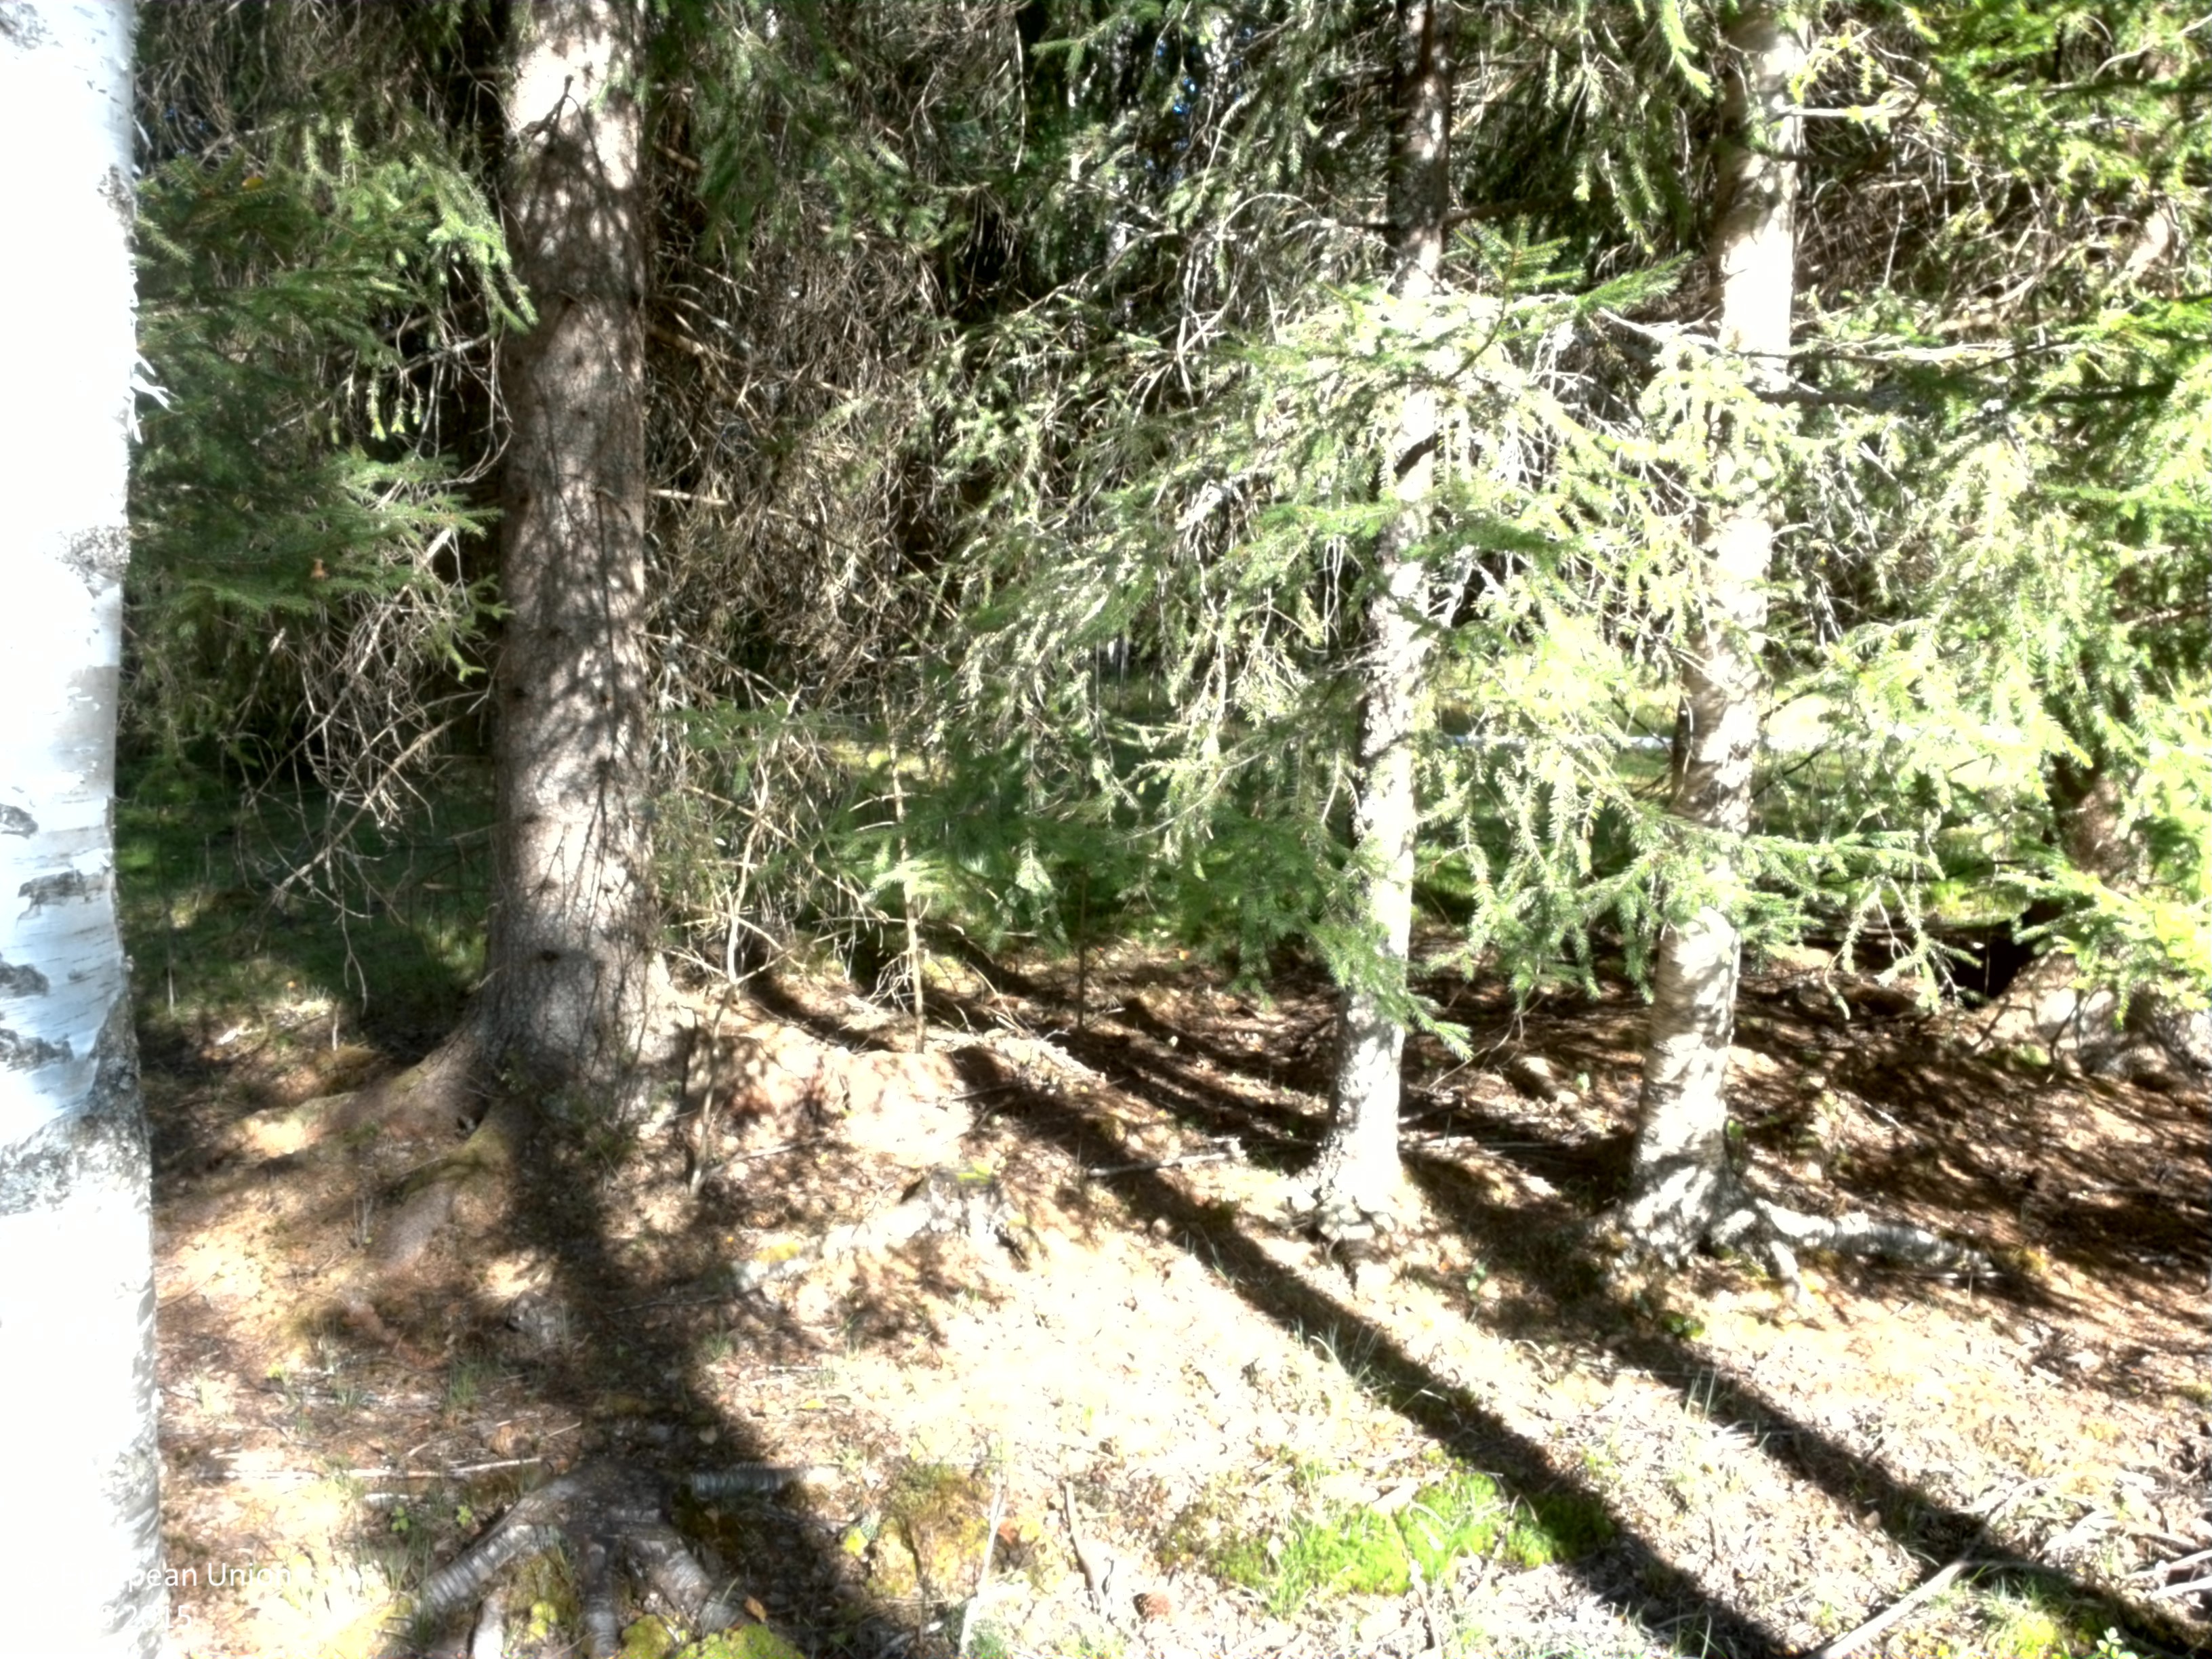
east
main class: Woodland
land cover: Broadleaved woodland
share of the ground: 50 - 75 %
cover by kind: broadleaved forest trees 50 %, herbaceous plants 40 %, coniferous forest trees 10 %
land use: Agriculture (excluding fallow land and kitchen gardens)
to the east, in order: Broadleaved woodland; Ditches and canals; Broadleaved woodland; Fences; Broadleaved woodland; Spruce dominated mixed woodland; Pine dominated mixed woodland; Tracks; Fences; Pine dominated mixed woodland; Fences; Pine dominated mixed woodland; Pine dominated coniferous woodland
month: August
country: SE
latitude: 59.9369
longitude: 14.2314
